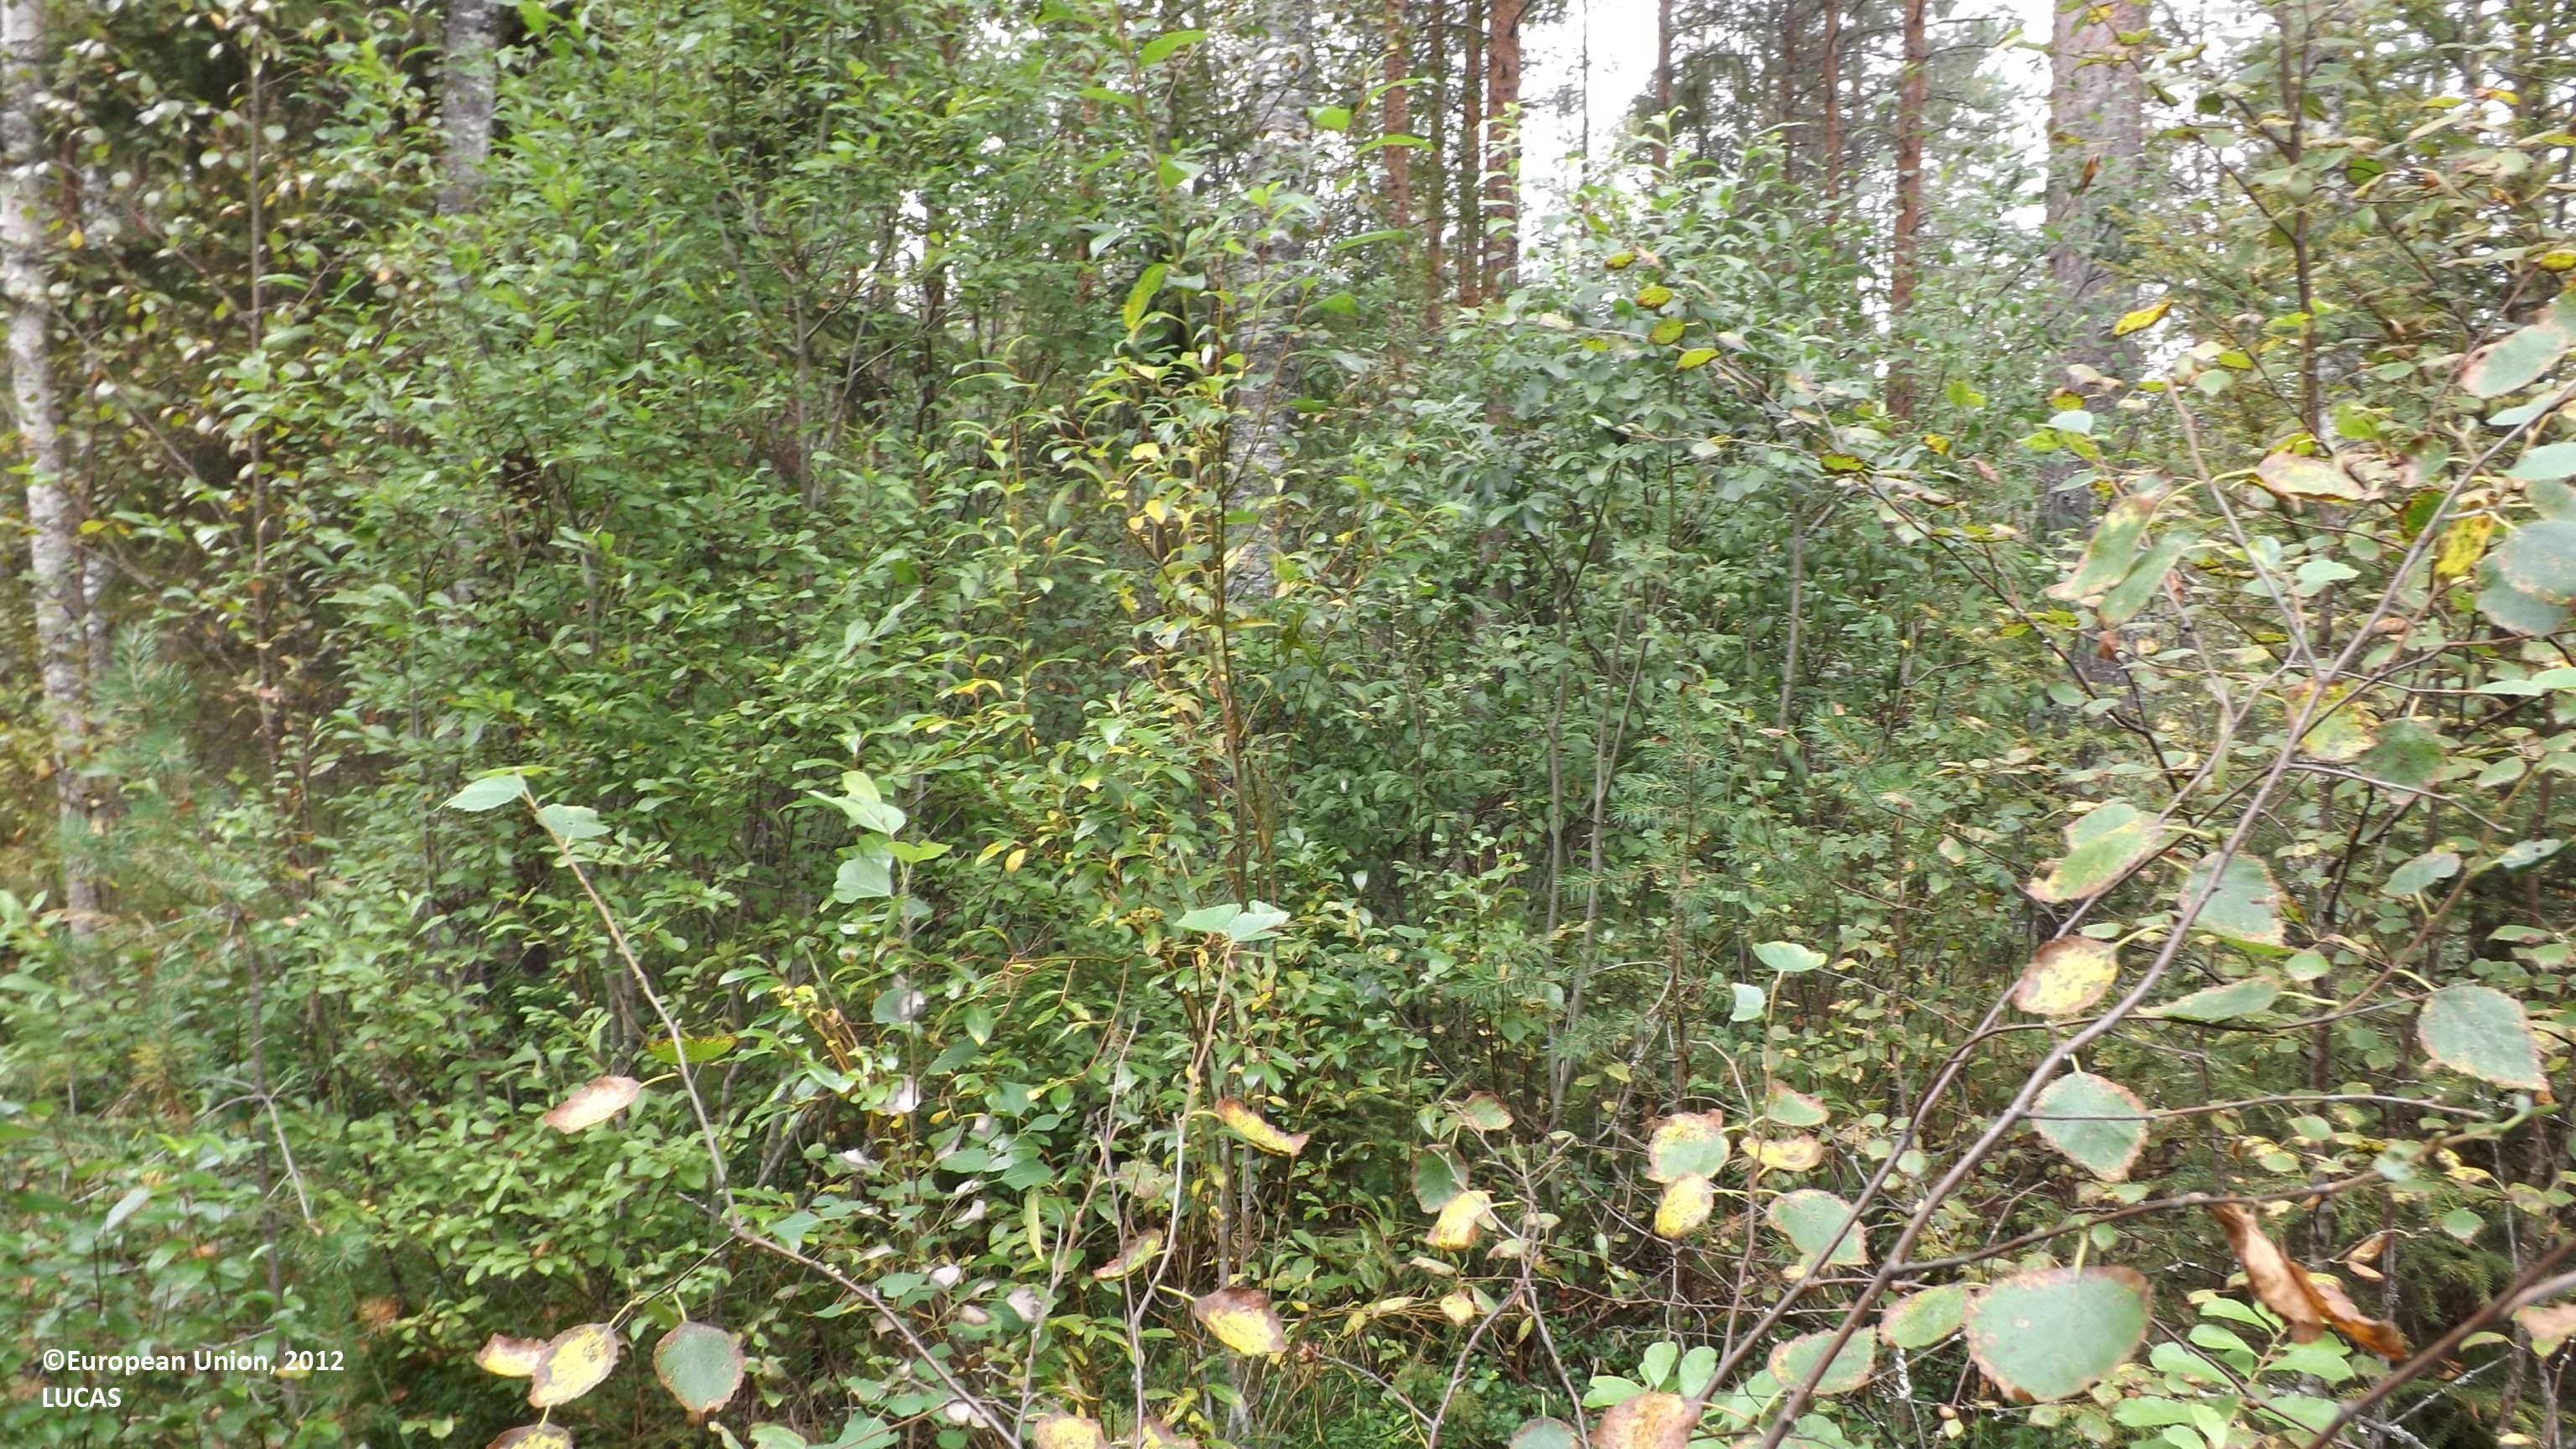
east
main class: Woodland
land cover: Other mixed woodland
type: boreal forest
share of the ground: 50 - 75 %
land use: Forestry
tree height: < 5 m
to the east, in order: Other mixed woodland; Ditches and canals; Other mixed woodland; Ditches and canals; Other mixed woodland; Ditches and canals; Other mixed woodland; Pine dominated mixed woodland; Pine dominated coniferous woodland; Ditches and canals; Pine dominated coniferous woodland; Pine dominated mixed woodland
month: August
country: FI
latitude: 63.8367
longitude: 24.1153
